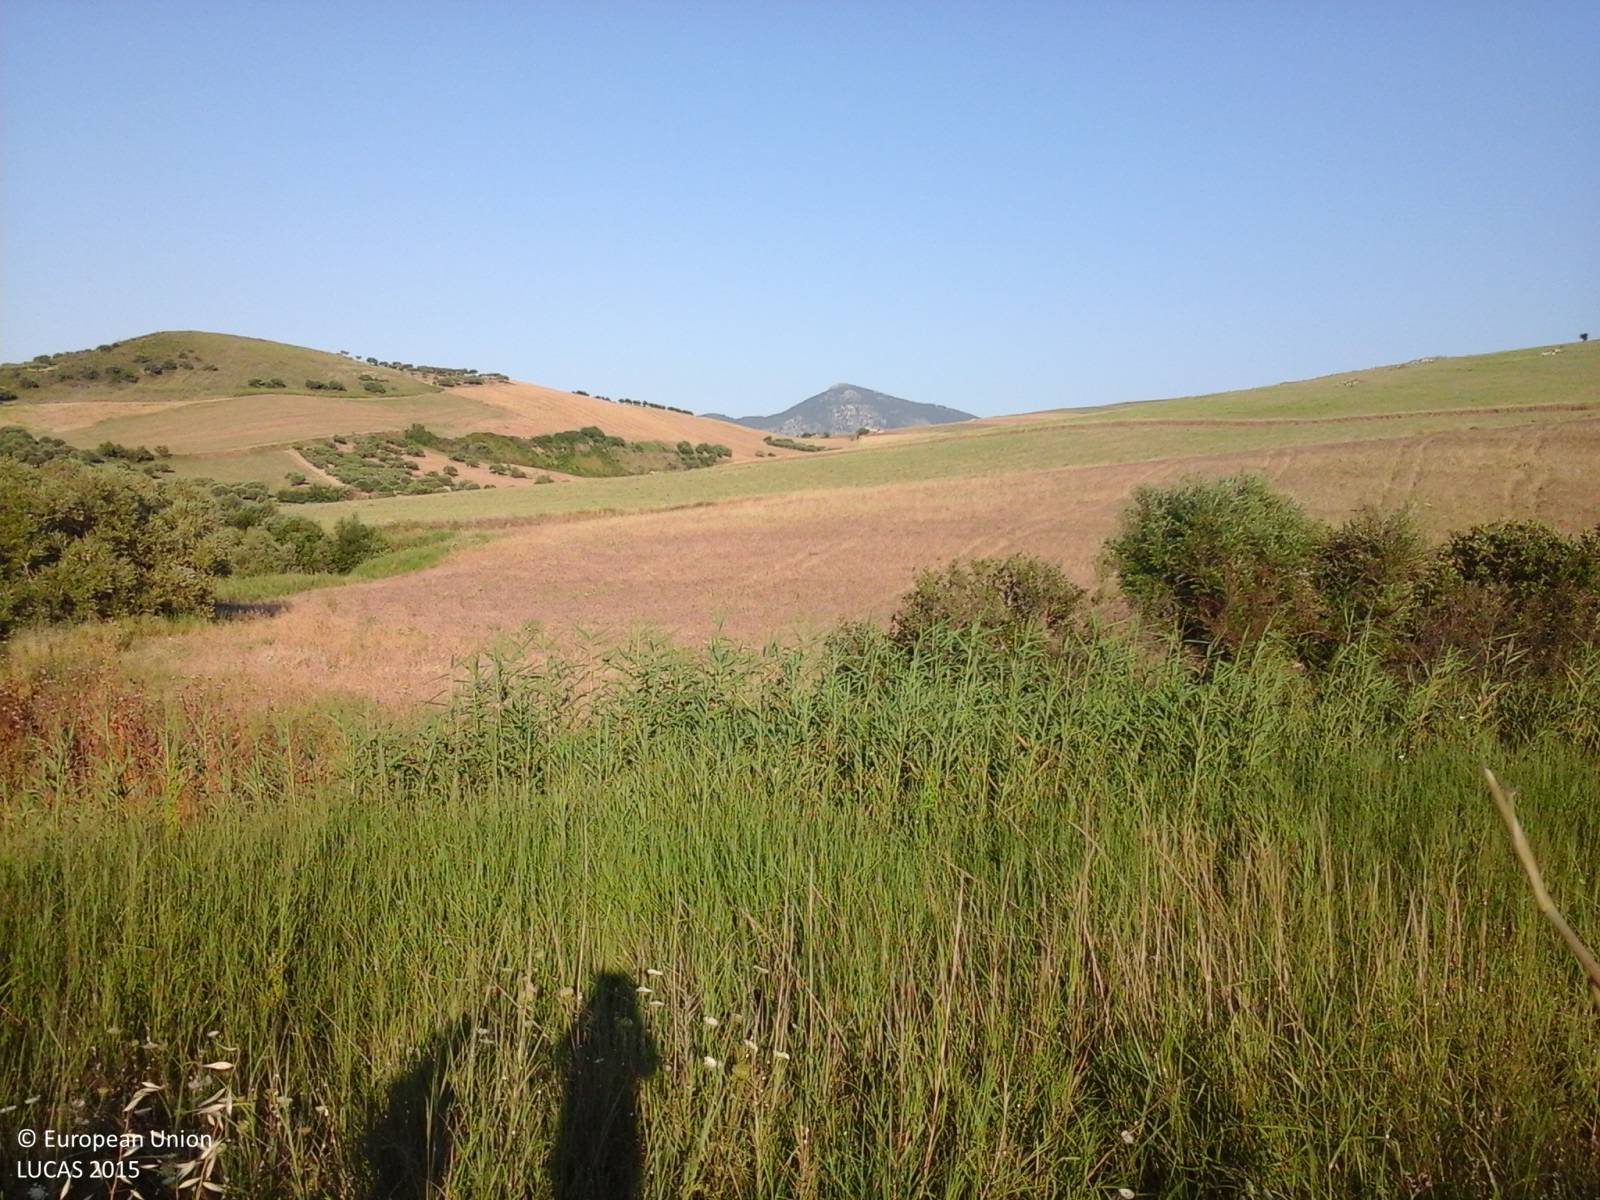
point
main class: Cropland
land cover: Durum wheat
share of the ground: > 75 %
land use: Agriculture (excluding fallow land and kitchen gardens)
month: July
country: IT
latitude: 37.7486
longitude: 13.1882
